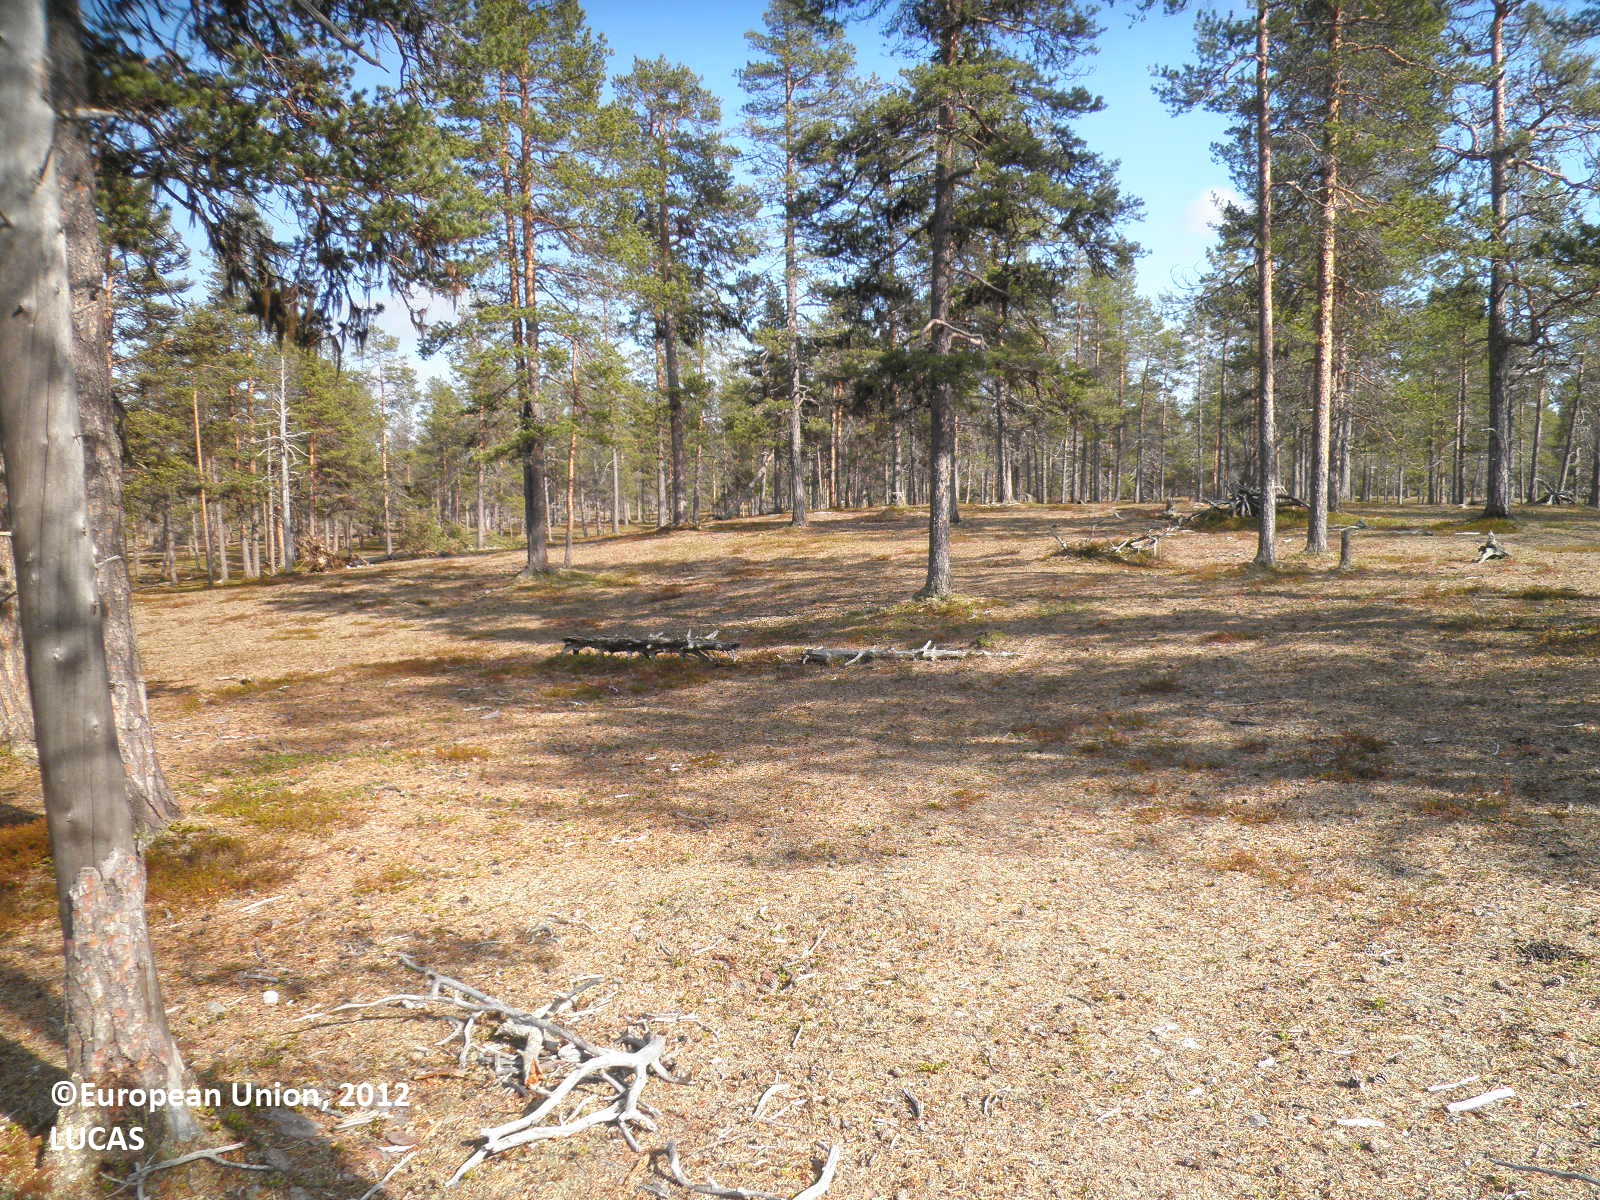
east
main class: Woodland
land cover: Pine dominated coniferous woodland
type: boreal forest
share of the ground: 10 - 25 %
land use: Forestry
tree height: > 5 m
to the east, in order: Pine dominated coniferous woodland
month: June
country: FI
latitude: 68.9009
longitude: 26.0936
